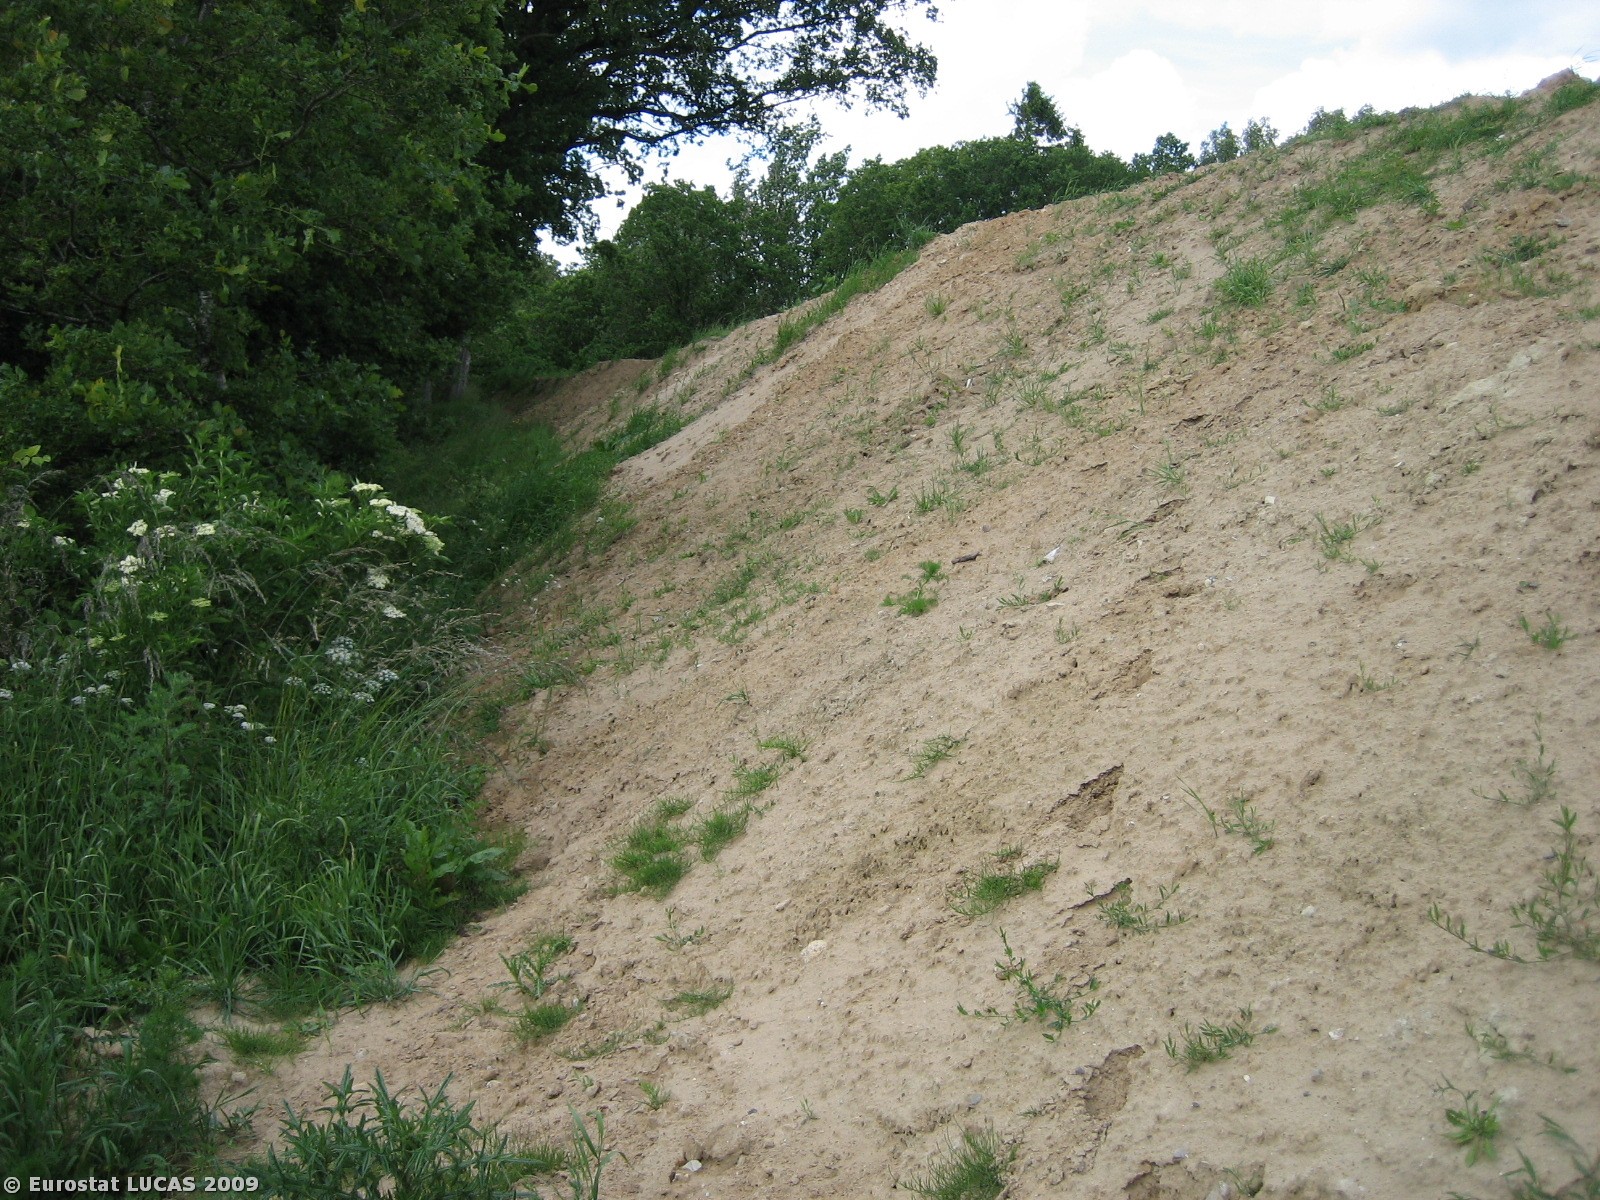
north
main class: Woodland
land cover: Broadleaved woodland
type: mesophytic deciduous forest
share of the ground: > 75 %
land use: Forestry
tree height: > 5 m
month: June
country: DK
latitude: 55.6102
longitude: 9.2229
